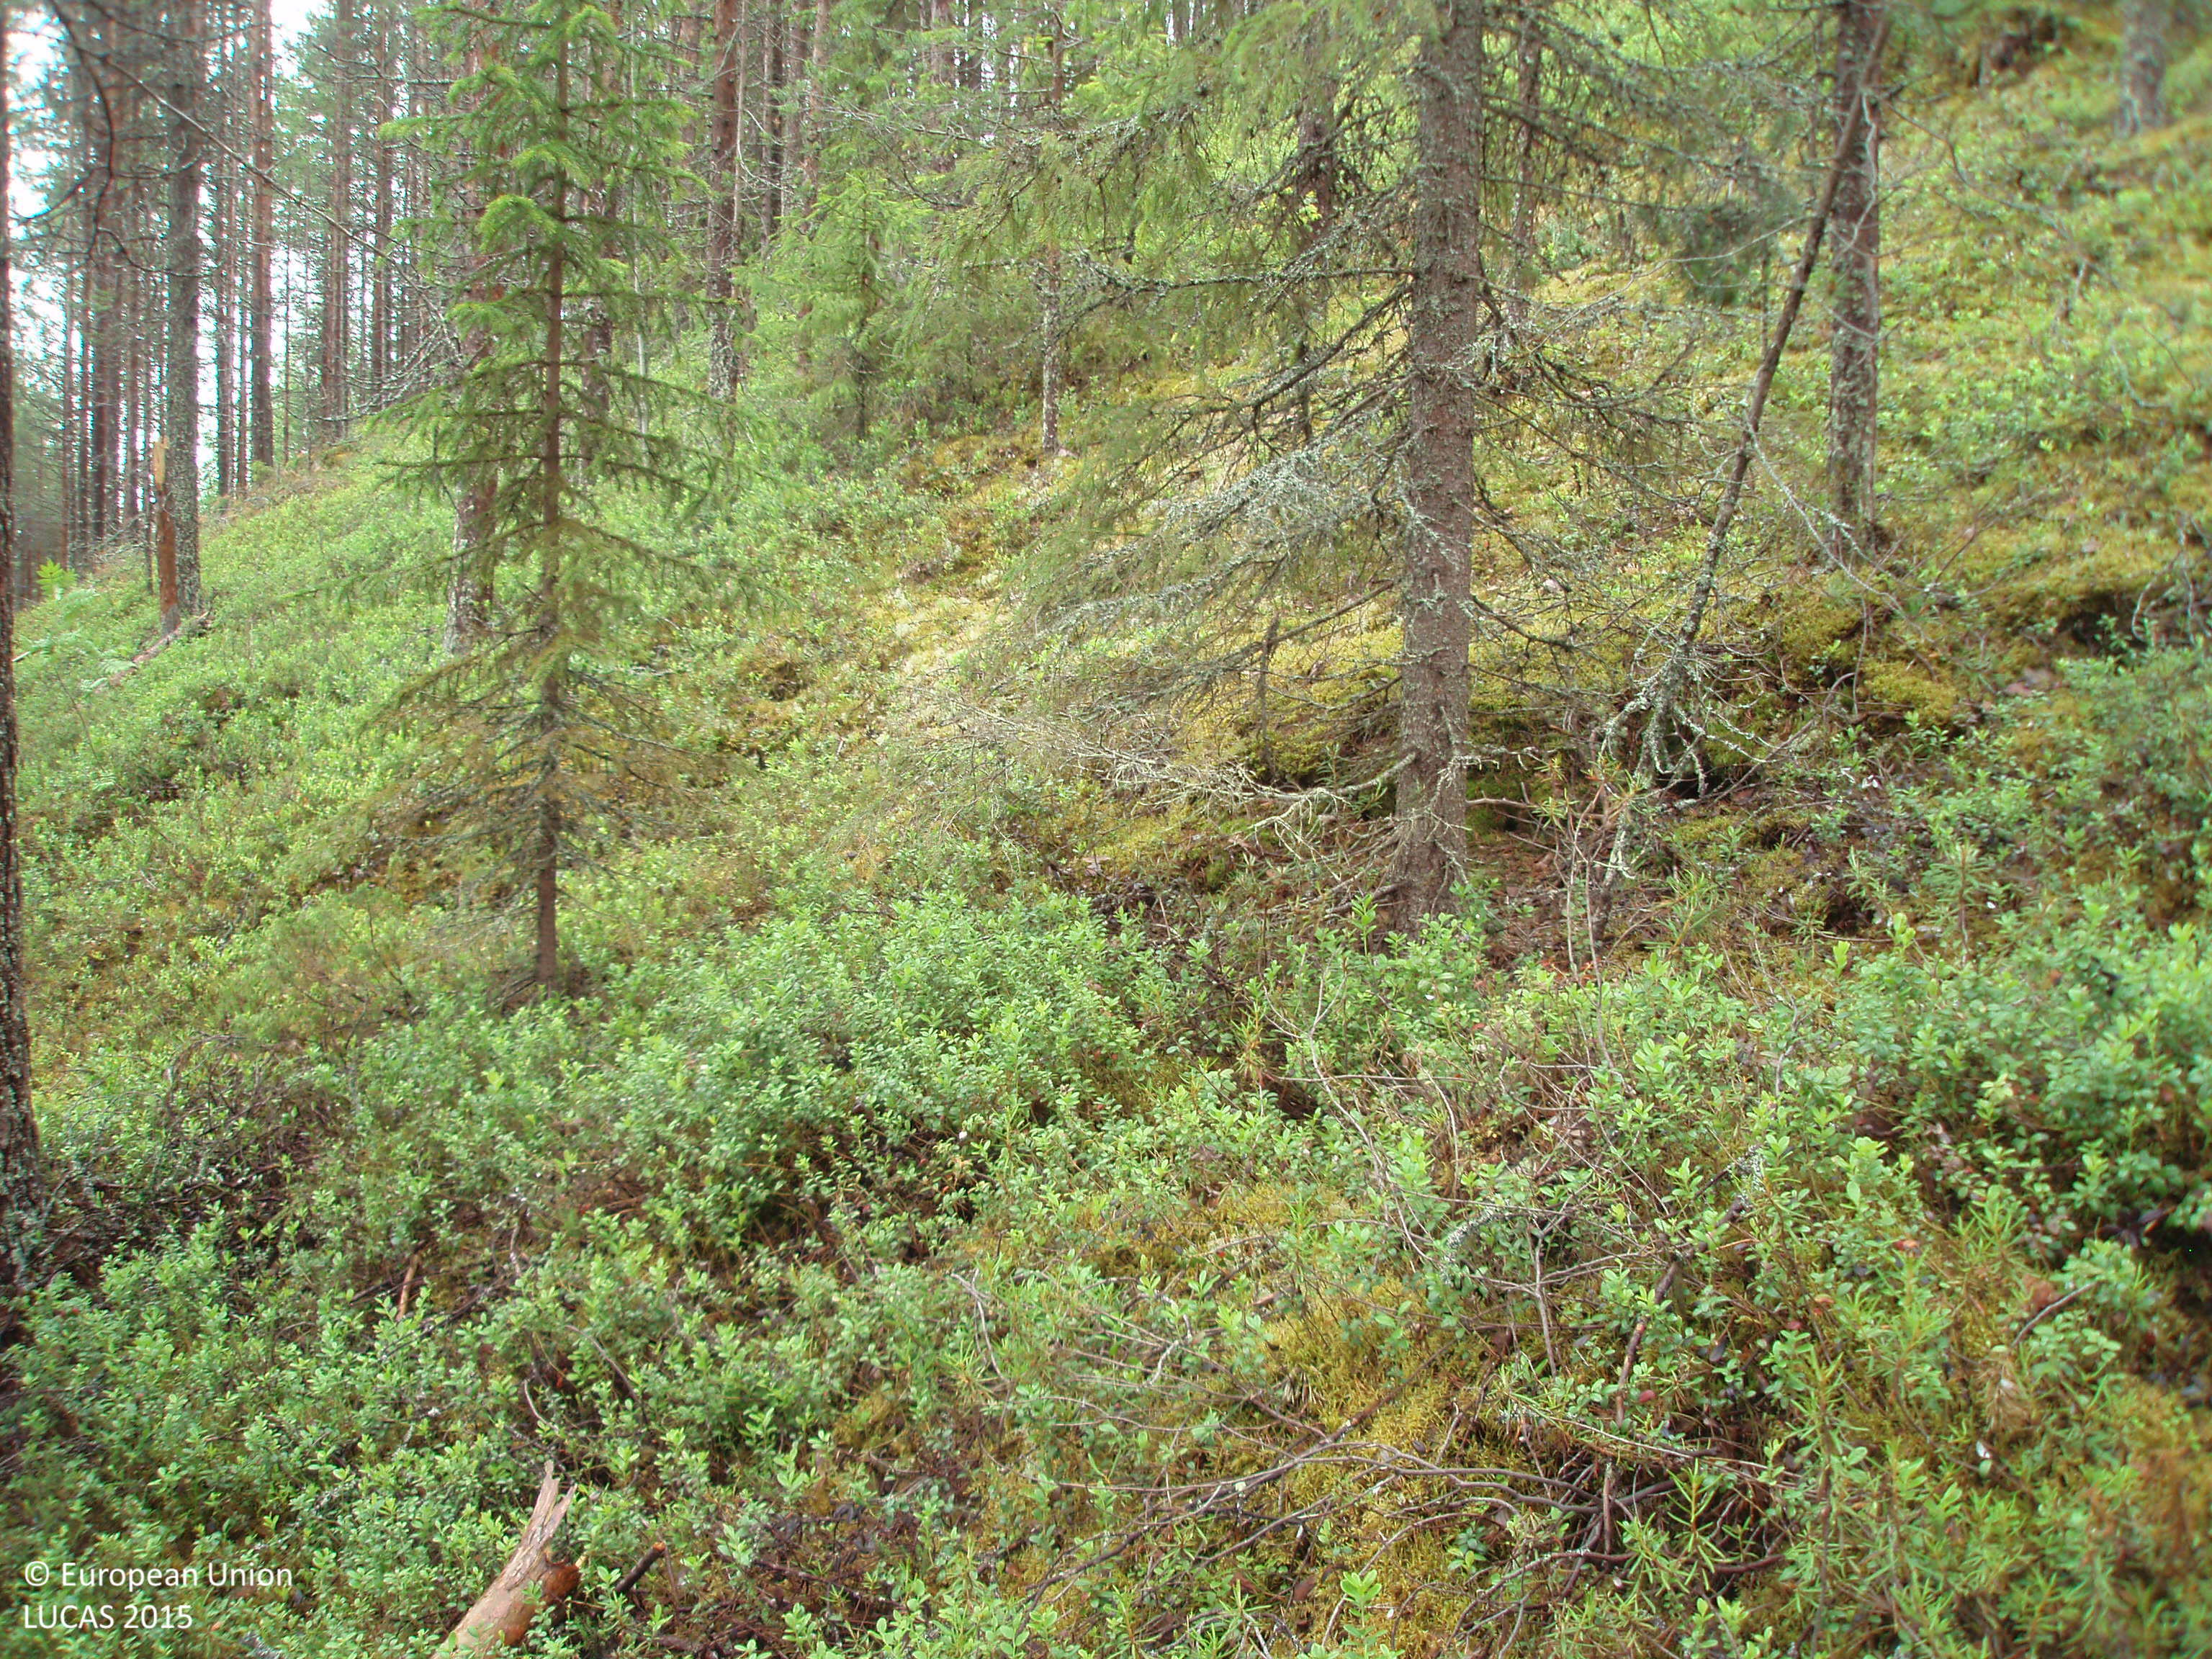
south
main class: Woodland
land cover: Pine dominated coniferous woodland
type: boreal forest
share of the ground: 50 - 75 %
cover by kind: coniferous forest trees 70 %, shrubs 30 %
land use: Forestry
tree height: > 5 m
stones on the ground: 10 - 25 %
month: July
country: FI
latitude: 67.2351
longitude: 28.4020
